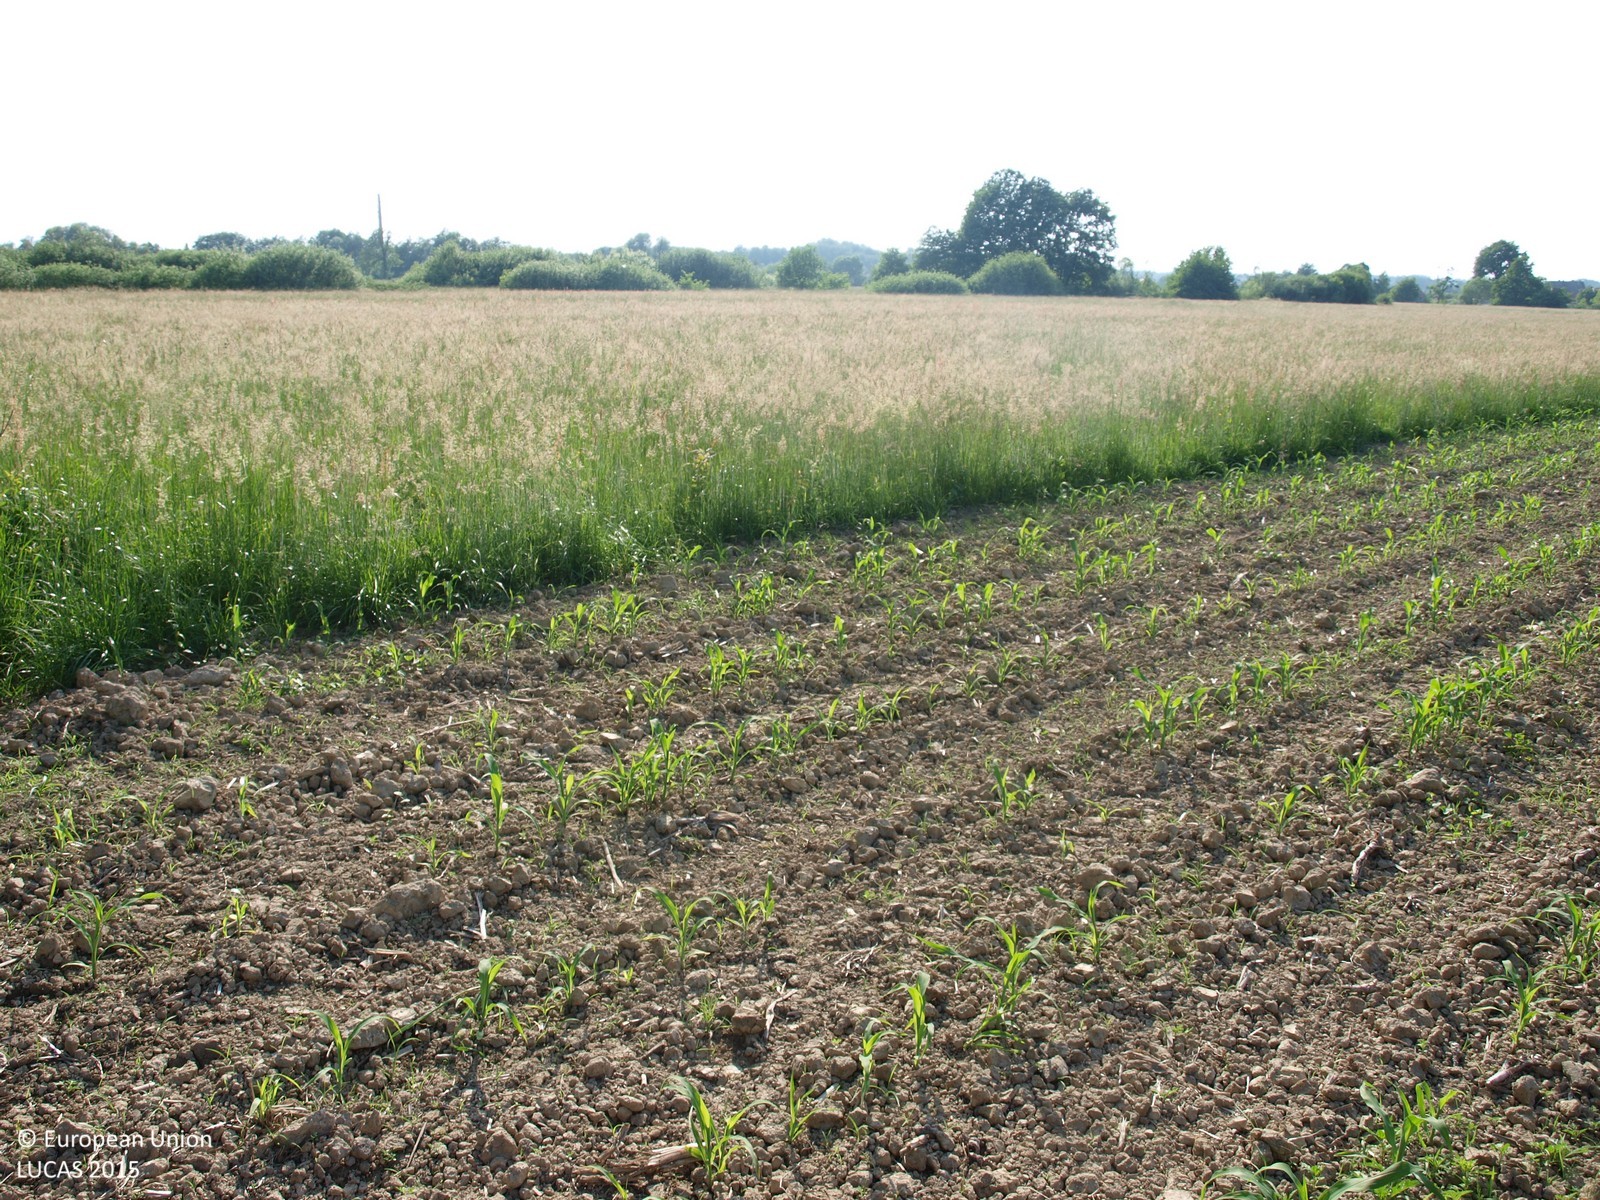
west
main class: Cropland
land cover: Maize
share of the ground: 25 - 50 %
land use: Agriculture (excluding fallow land and kitchen gardens)
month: May
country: HR
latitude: 46.2608
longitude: 16.2140
